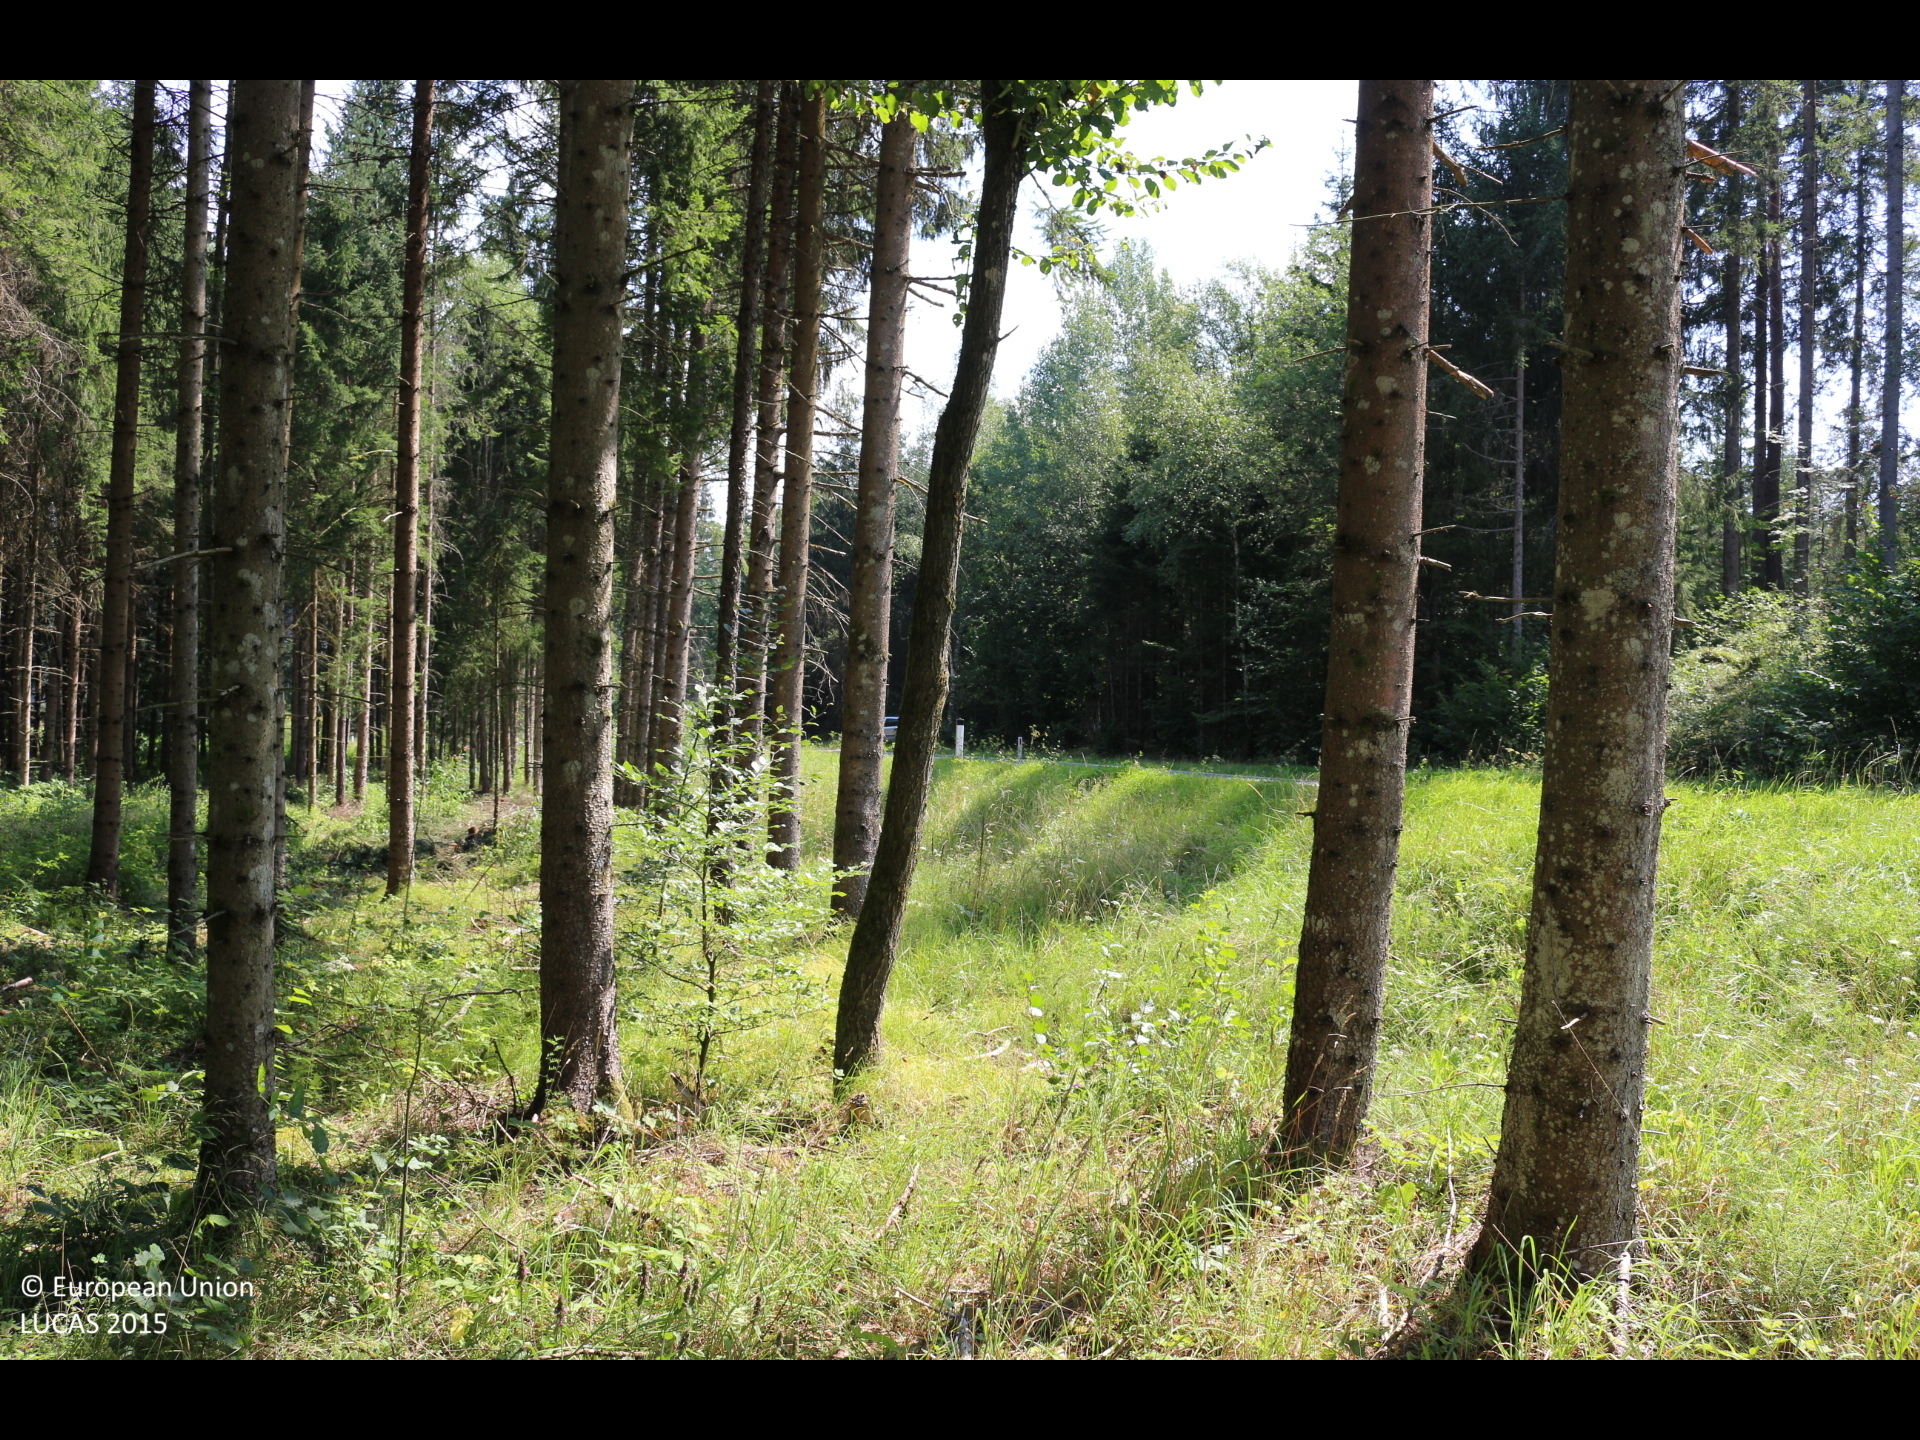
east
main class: Woodland
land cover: Spruce dominated coniferous woodland
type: alpine coniferous forest
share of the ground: > 75 %
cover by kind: coniferous forest trees 80 %, herbaceous plants 15 %, broadleaved forest trees 5 %
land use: Forestry
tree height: > 5 m
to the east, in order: Spruce dominated coniferous woodland; Grass margins; Paved roads, cycling and walking lanes; Grass margins; Spruce dominated mixed woodland; Spruce dominated coniferous woodland; Tracks; Spruce dominated coniferous woodland; Spruce dominated mixed woodland; Broadleaved woodland; Inland fresh running water; Spruce dominated mixed woodland
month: August
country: AT
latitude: 46.8486
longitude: 14.1287
